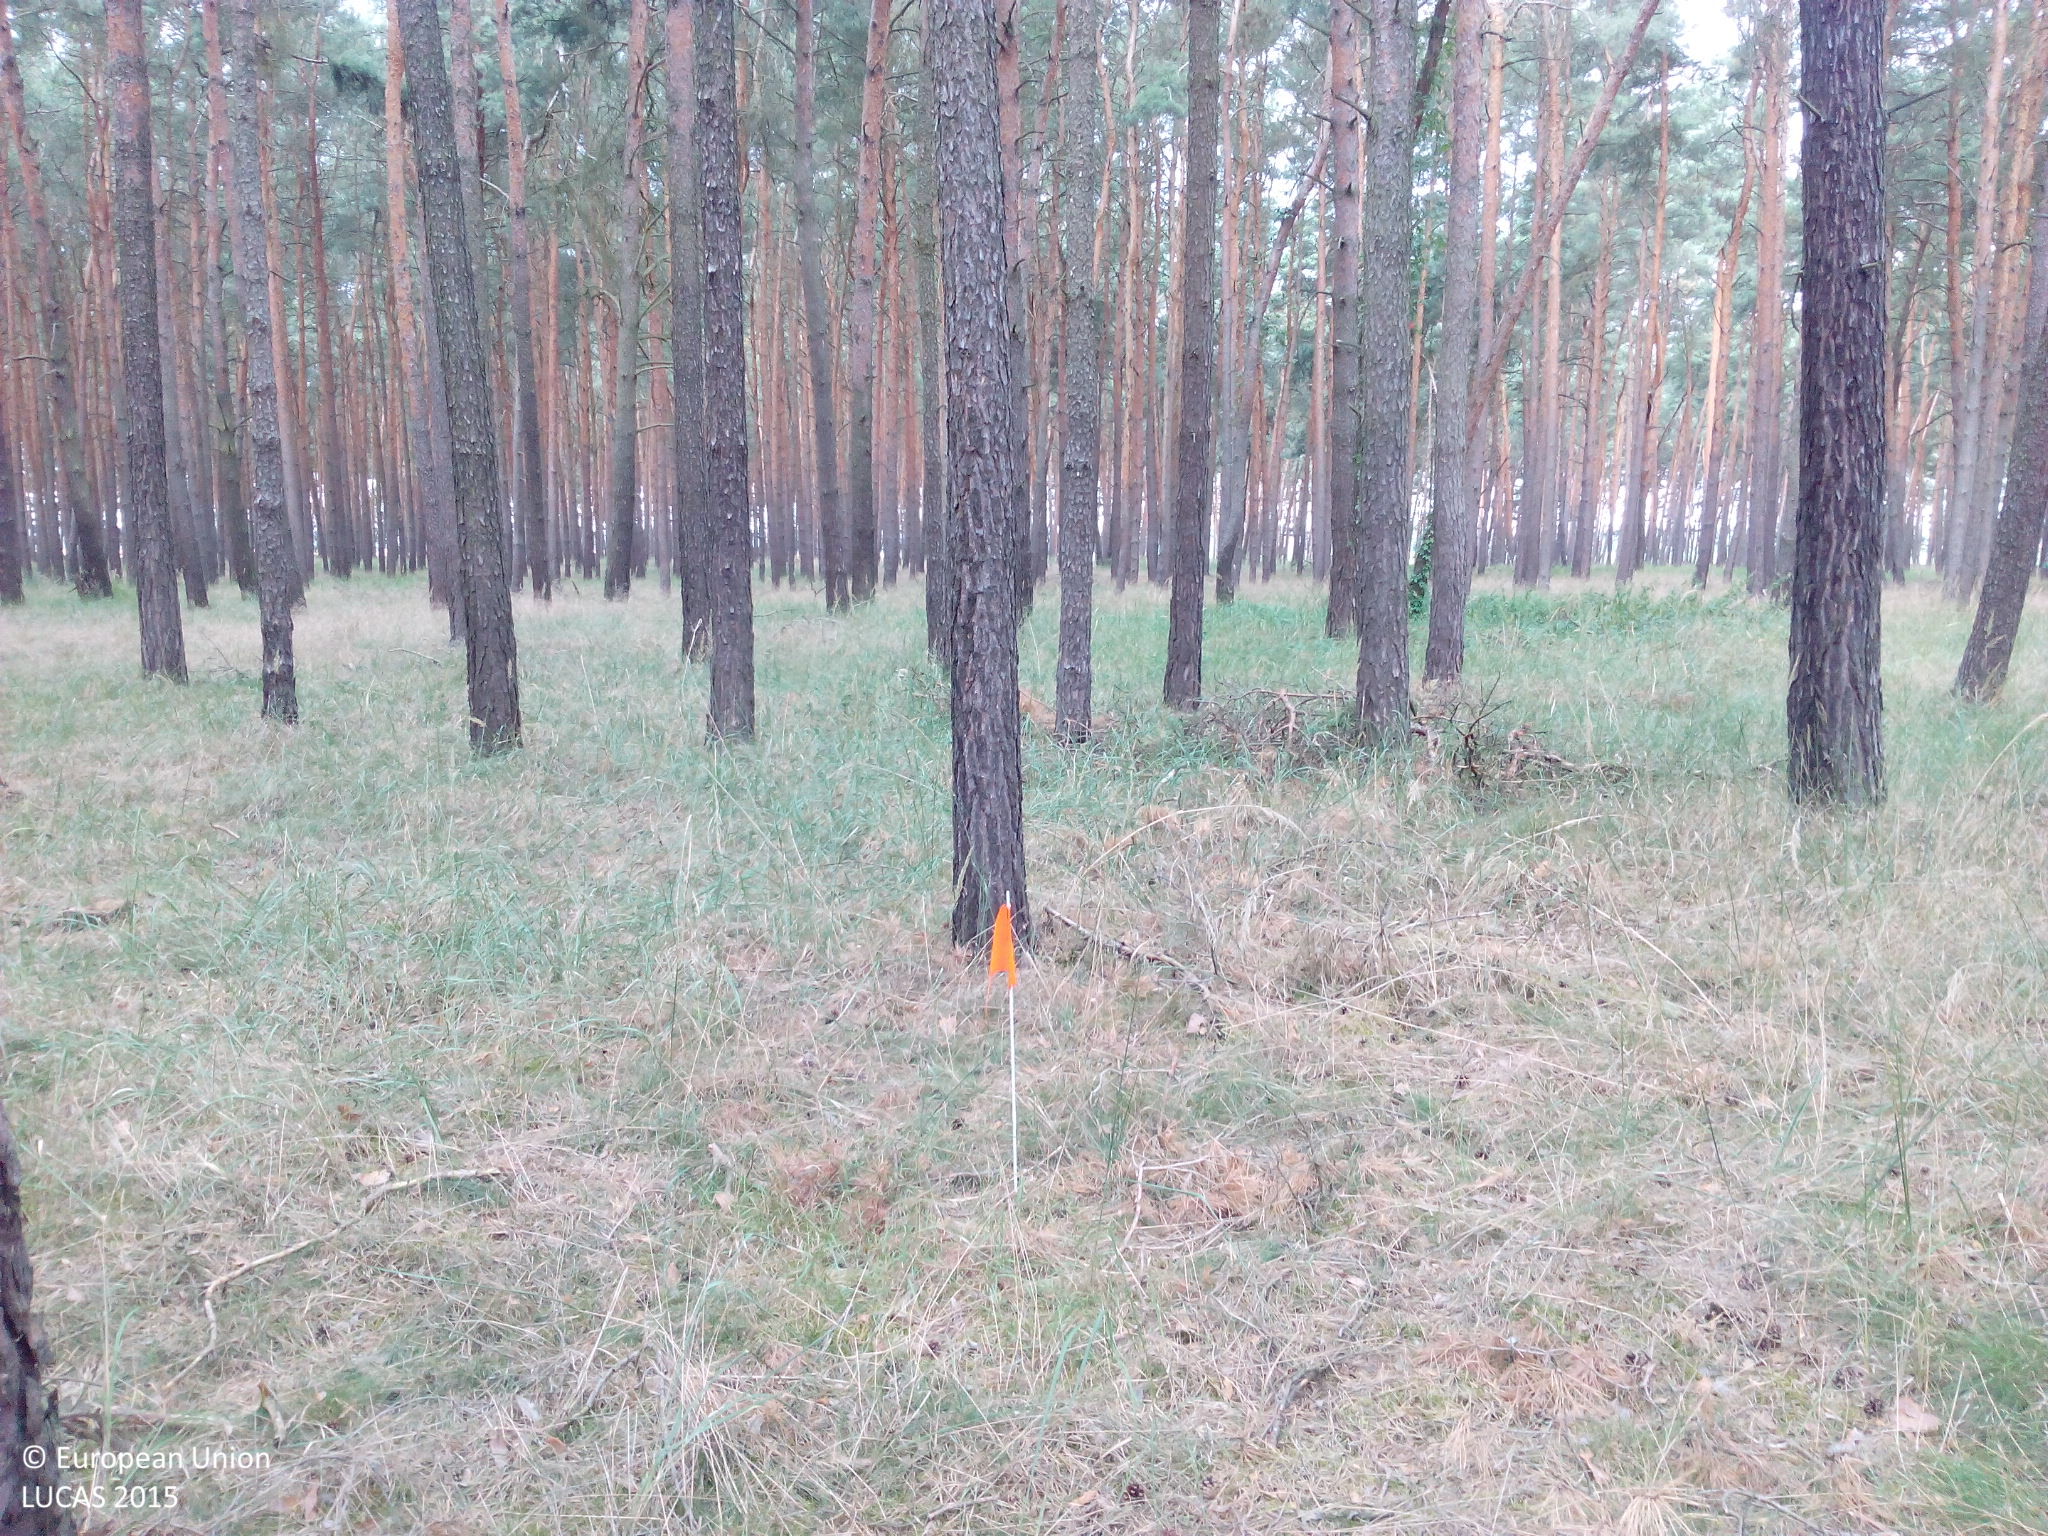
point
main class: Woodland
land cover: Pine dominated coniferous woodland
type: hemiboreal forest and nemoral coniferous forest and mixed broadleaved-coniferous forest
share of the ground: > 75 %
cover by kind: coniferous forest trees 85 %, unconsolidated bare surface 10 %, herbaceous plants 5 %
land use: Forestry
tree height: > 5 m
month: August
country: DE
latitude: 51.8687
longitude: 13.1225
